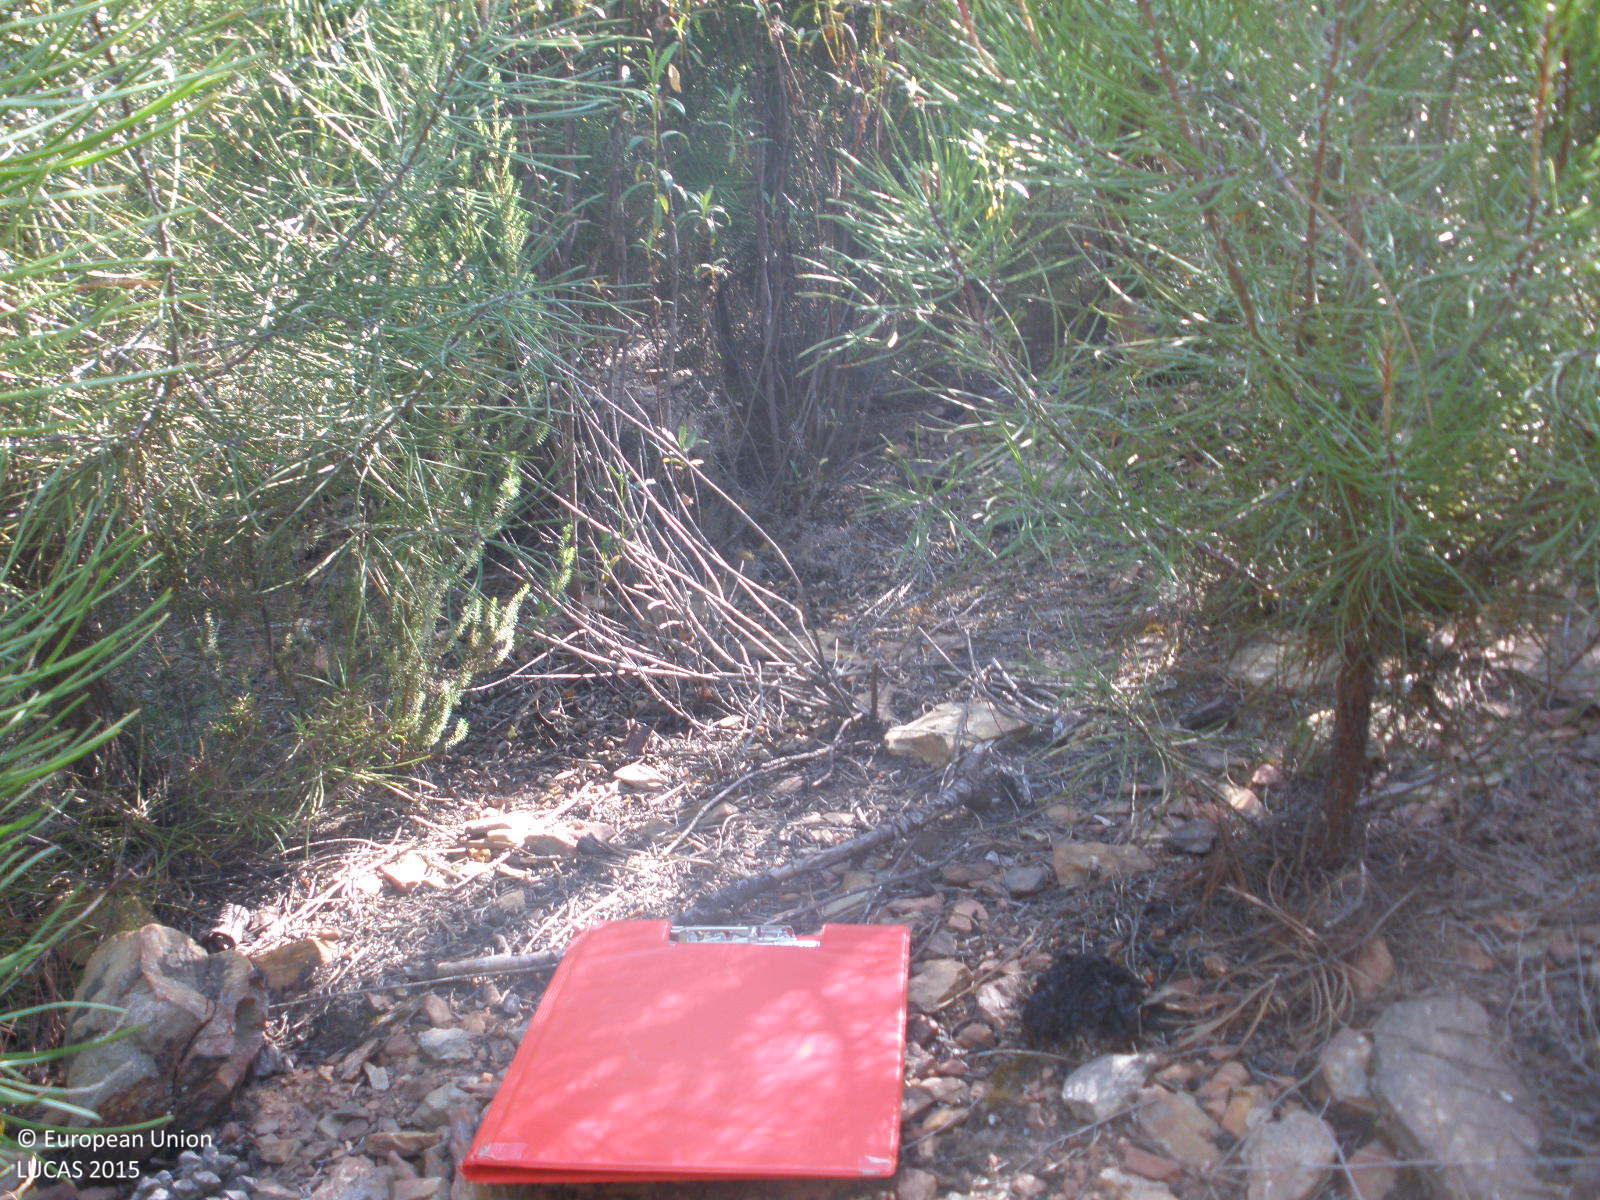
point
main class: Woodland
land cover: Pine dominated coniferous woodland
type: coniferous forest of the mediterranean region
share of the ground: > 75 %
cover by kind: coniferous forest trees 70 %, shrubs 30 %
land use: Forestry
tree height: < 5 m
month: May
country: ES
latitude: 40.4001
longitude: -6.2098
